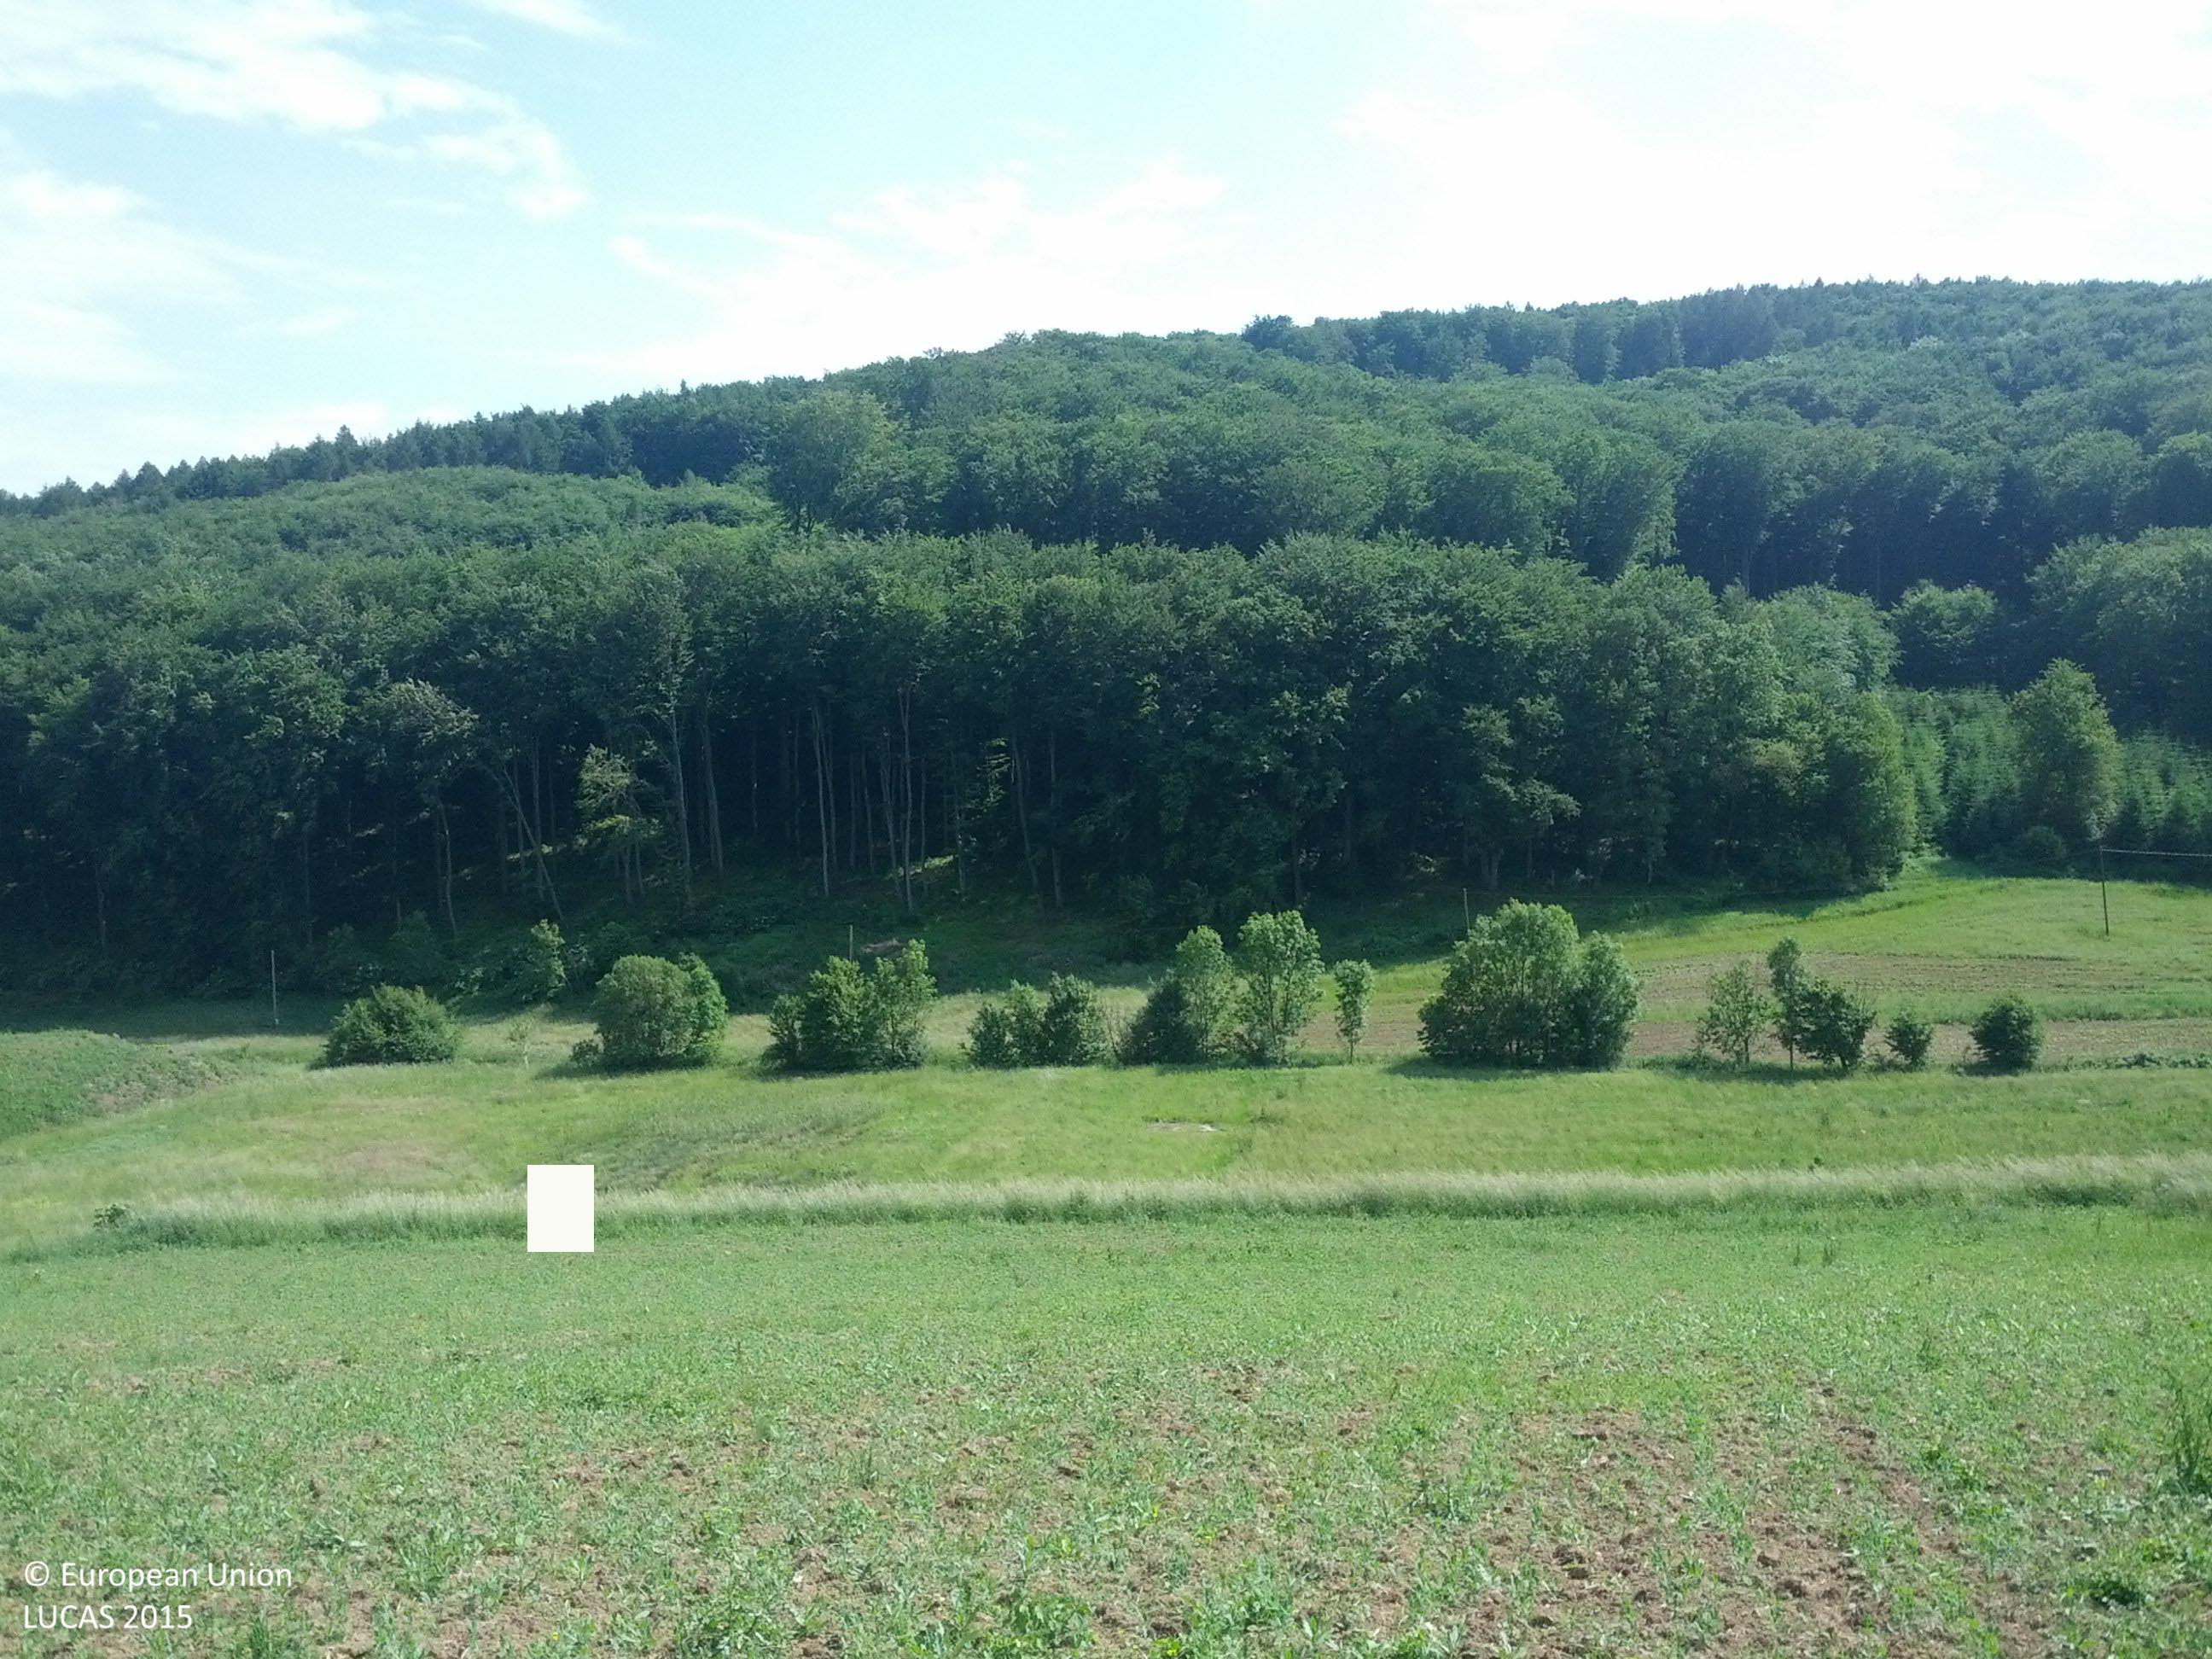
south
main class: Cropland
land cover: Dry pulses
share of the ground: 25 - 50 %
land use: Agriculture (excluding fallow land and kitchen gardens)
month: May
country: AT
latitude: 48.3185
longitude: 16.2216
